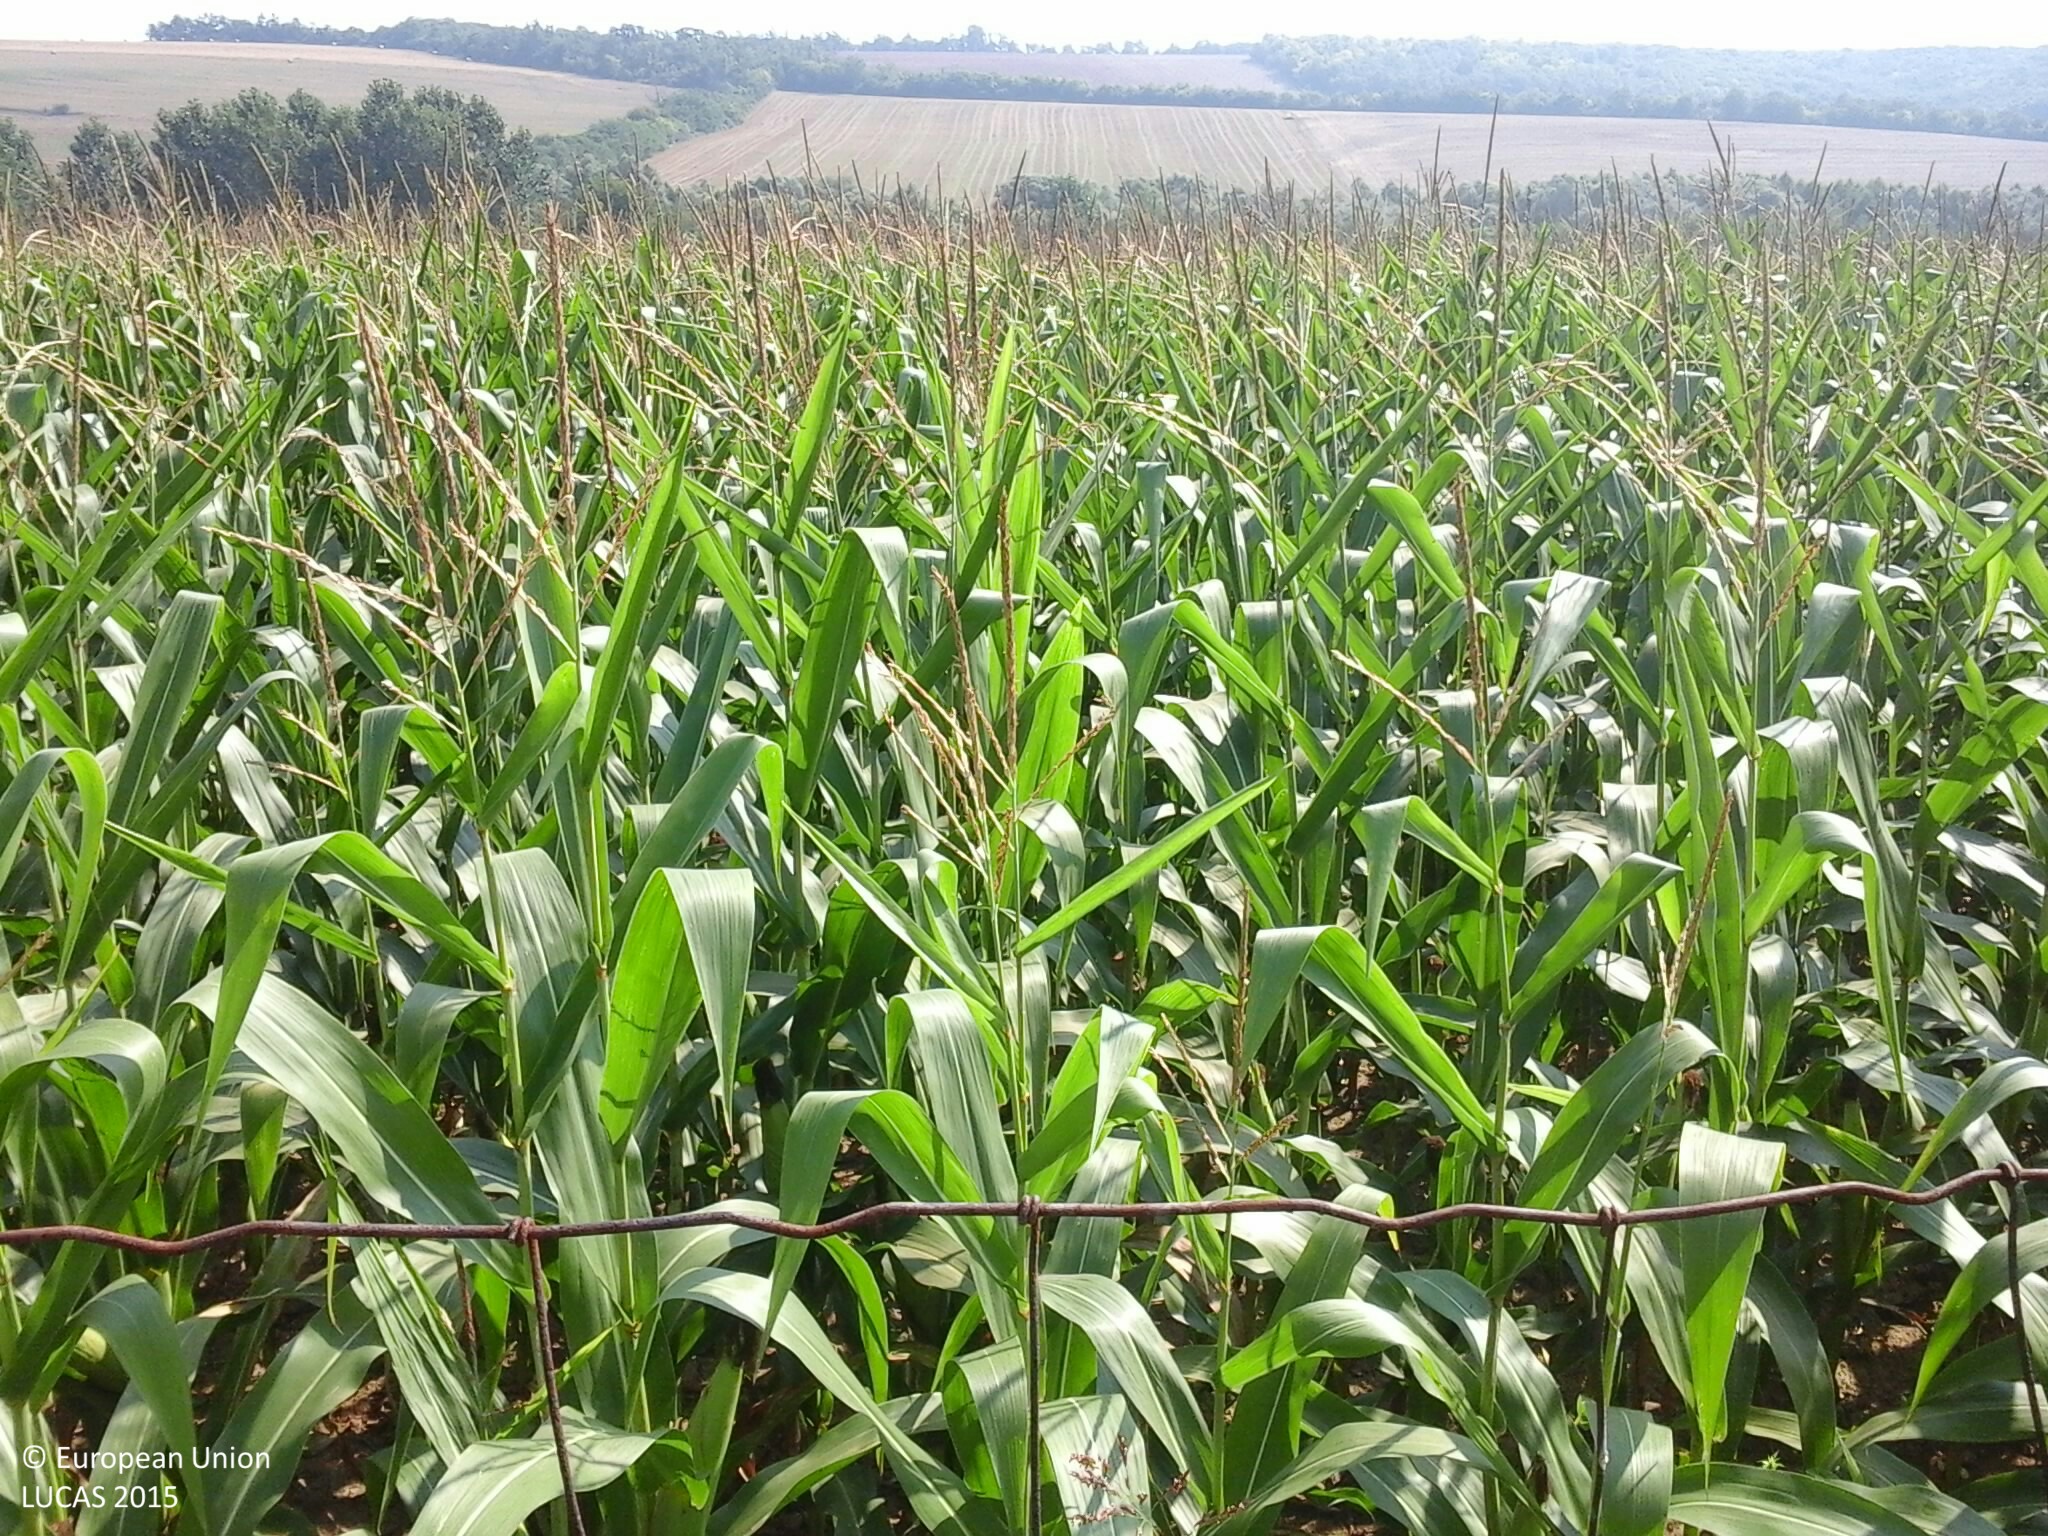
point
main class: Cropland
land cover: Maize
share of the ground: > 75 %
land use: Agriculture (excluding fallow land and kitchen gardens)
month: August
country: HU
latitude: 46.6171
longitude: 17.9338
